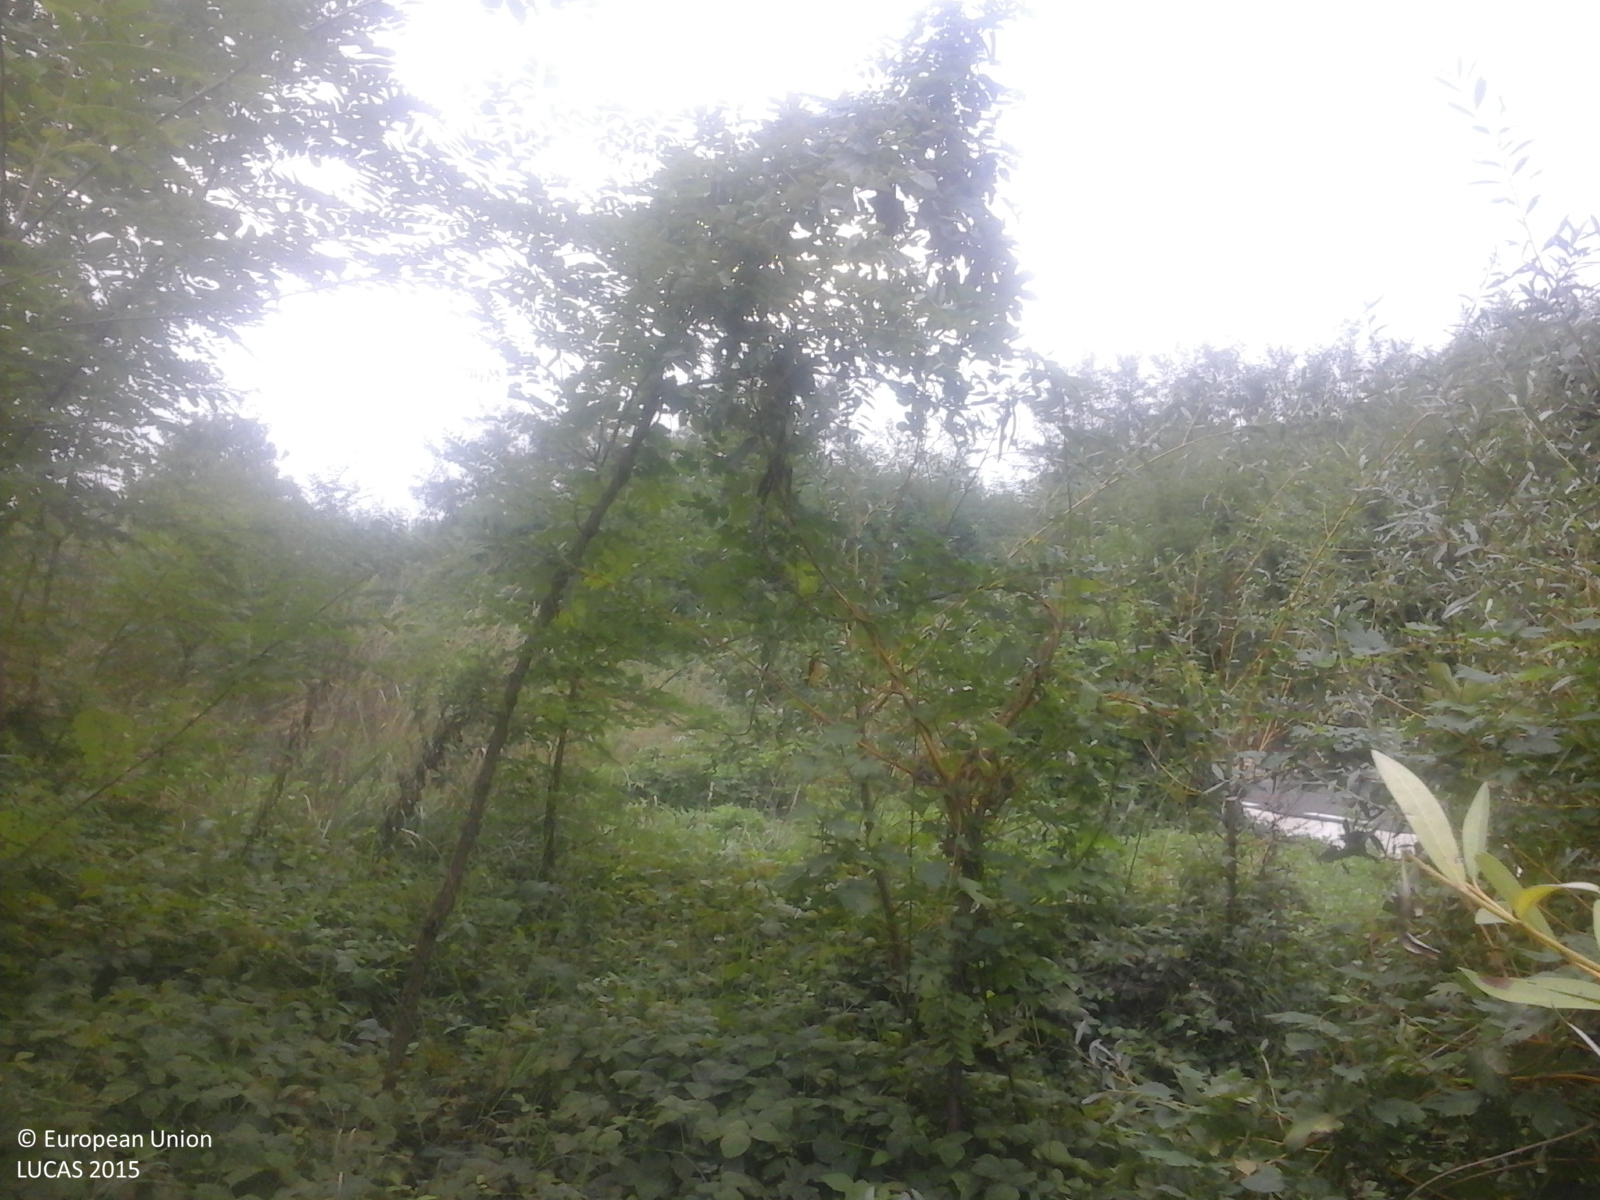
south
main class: Woodland
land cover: Broadleaved woodland
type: exotic forest
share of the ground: > 75 %
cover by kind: broadleaved forest trees 100 %
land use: Forestry
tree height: > 5 m
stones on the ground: < 10 %
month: September
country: RO
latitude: 44.8072
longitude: 24.2423
